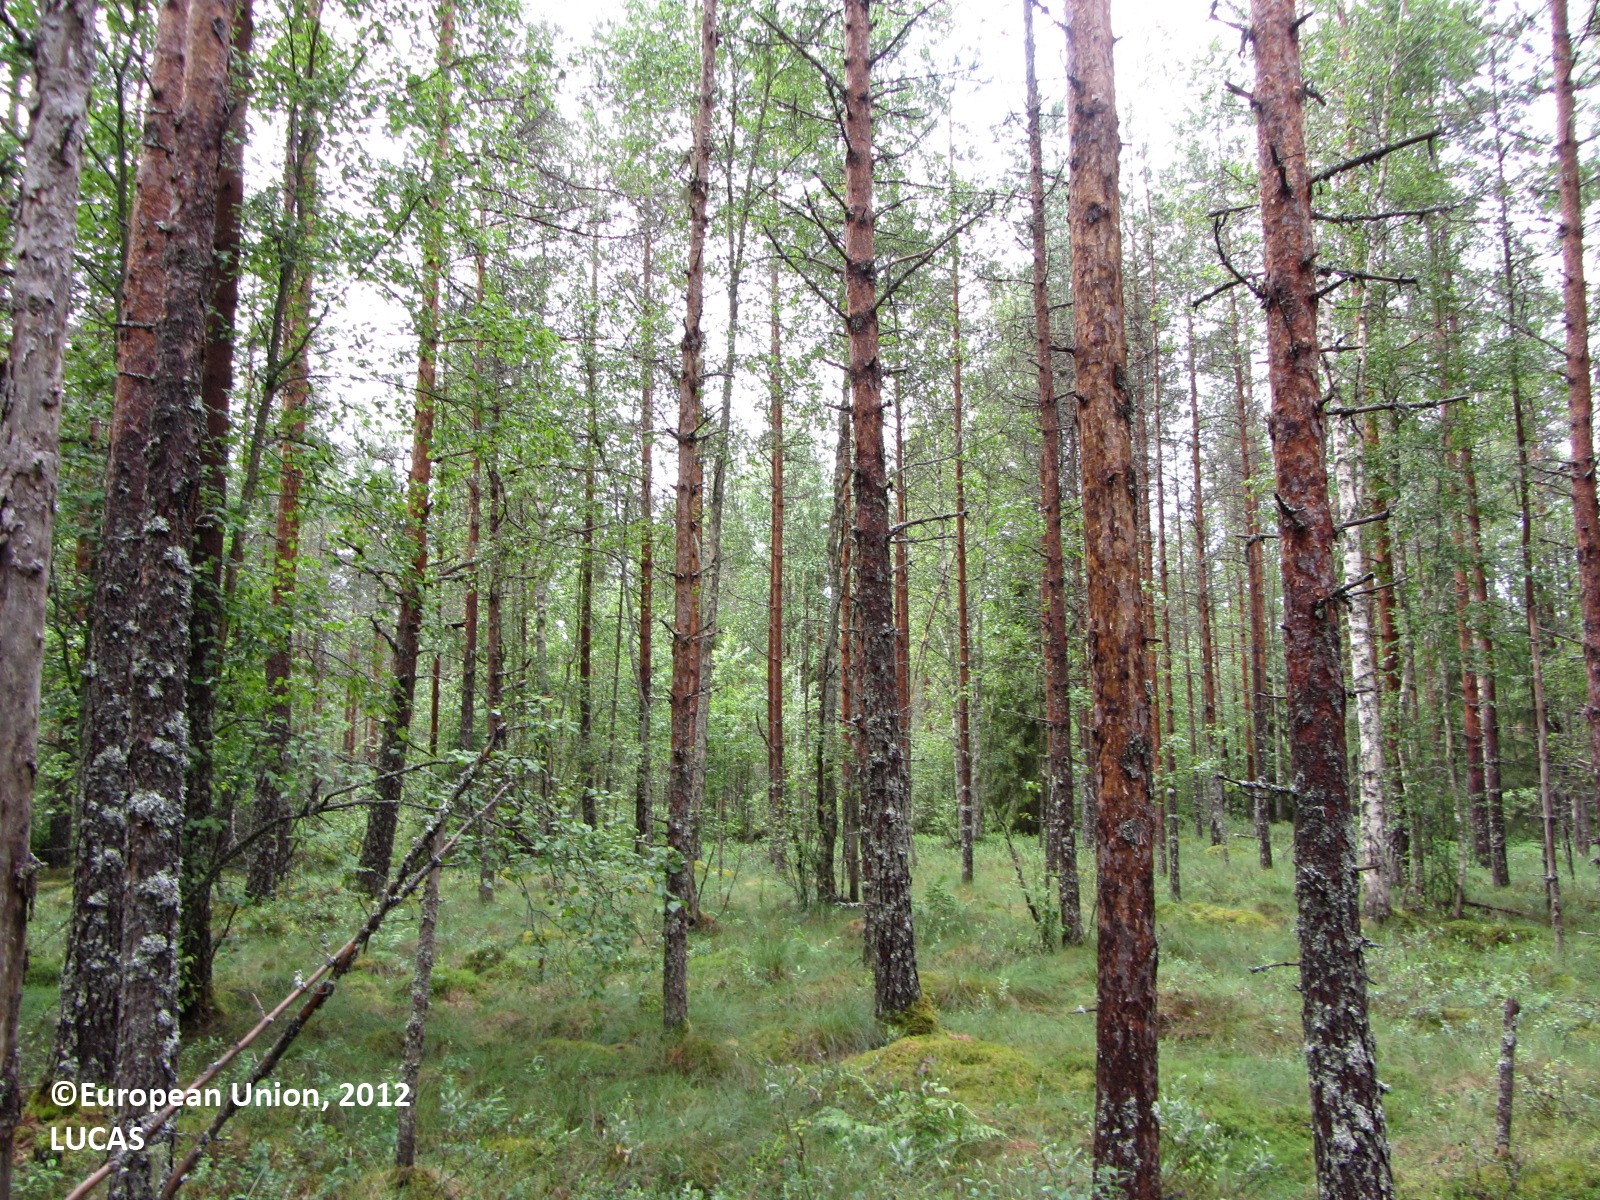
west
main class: Woodland
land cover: Pine dominated mixed woodland
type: boreal forest
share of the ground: > 75 %
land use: Forestry
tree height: > 5 m
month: July
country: FI
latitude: 63.8967
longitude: 25.6015
